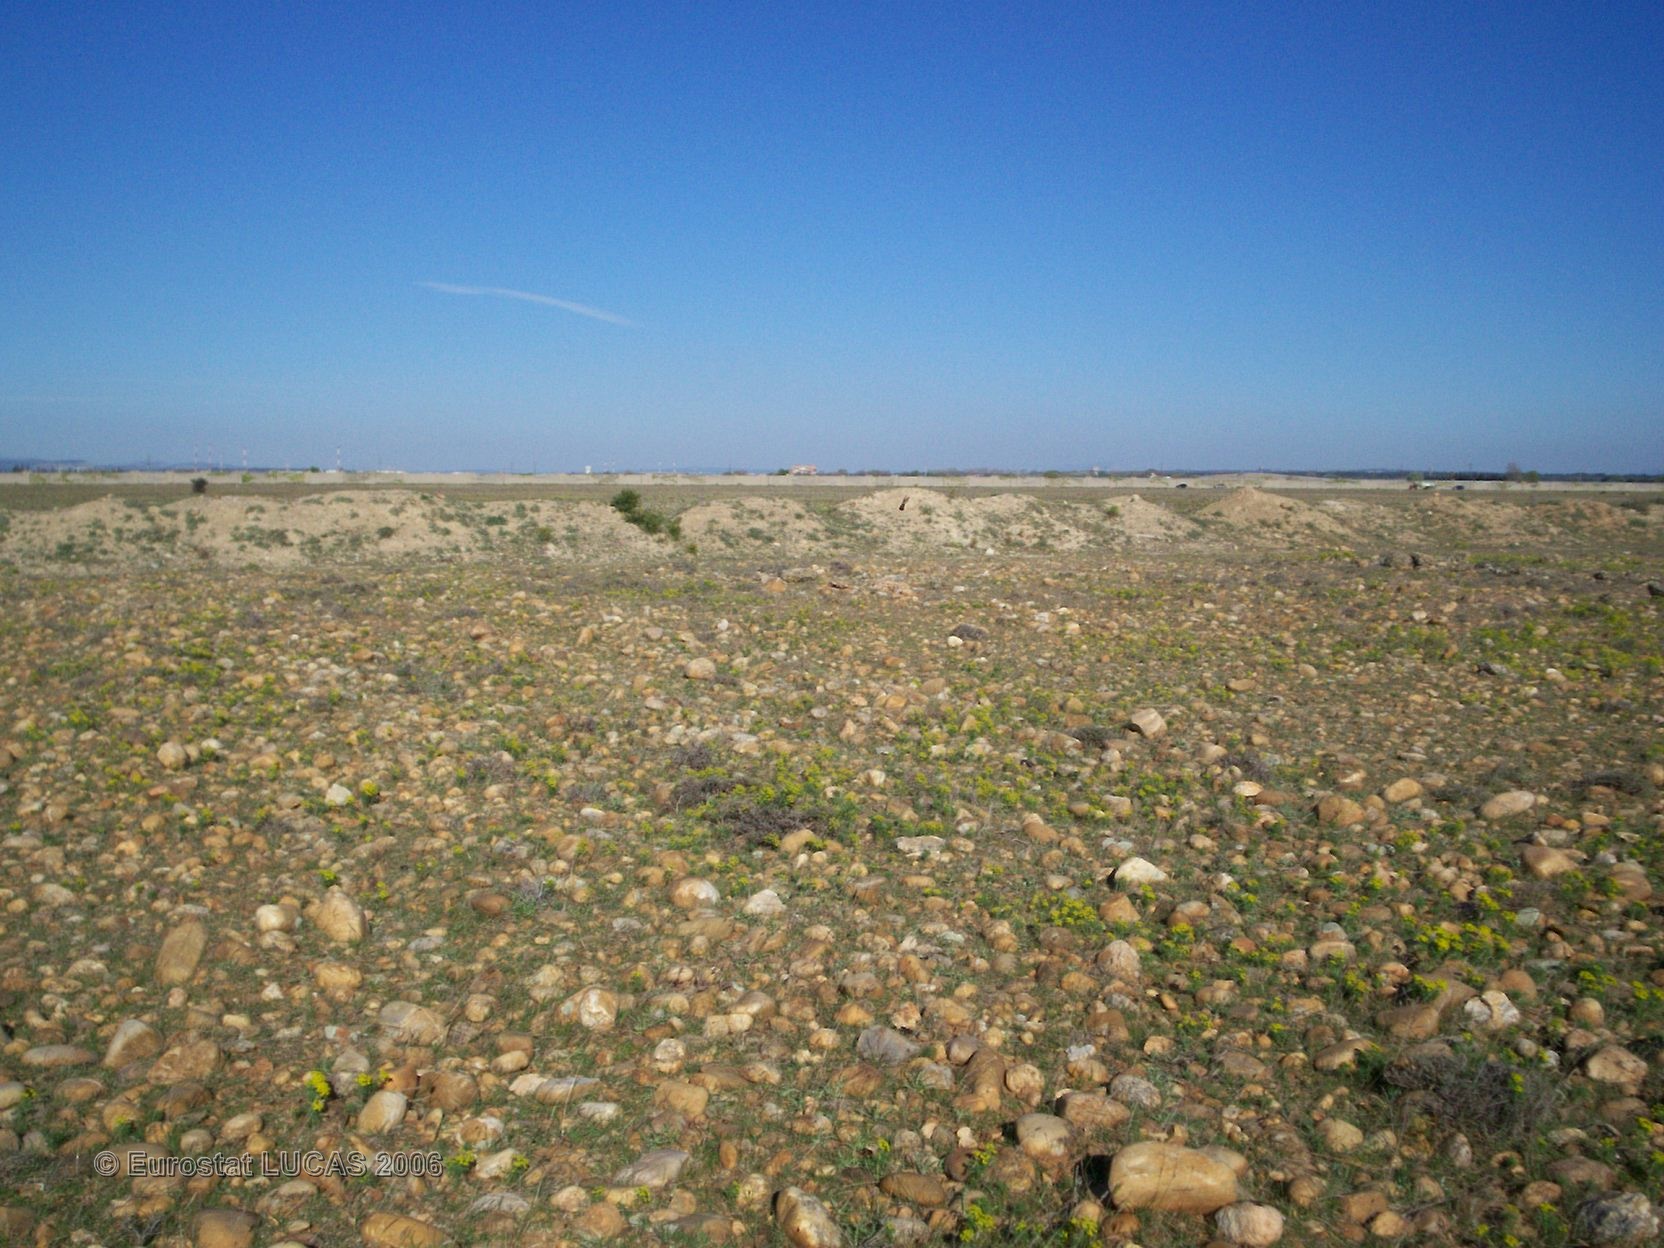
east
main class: Bare land
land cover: Bare land
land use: Unused
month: April
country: FR
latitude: 43.5767
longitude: 4.9450
